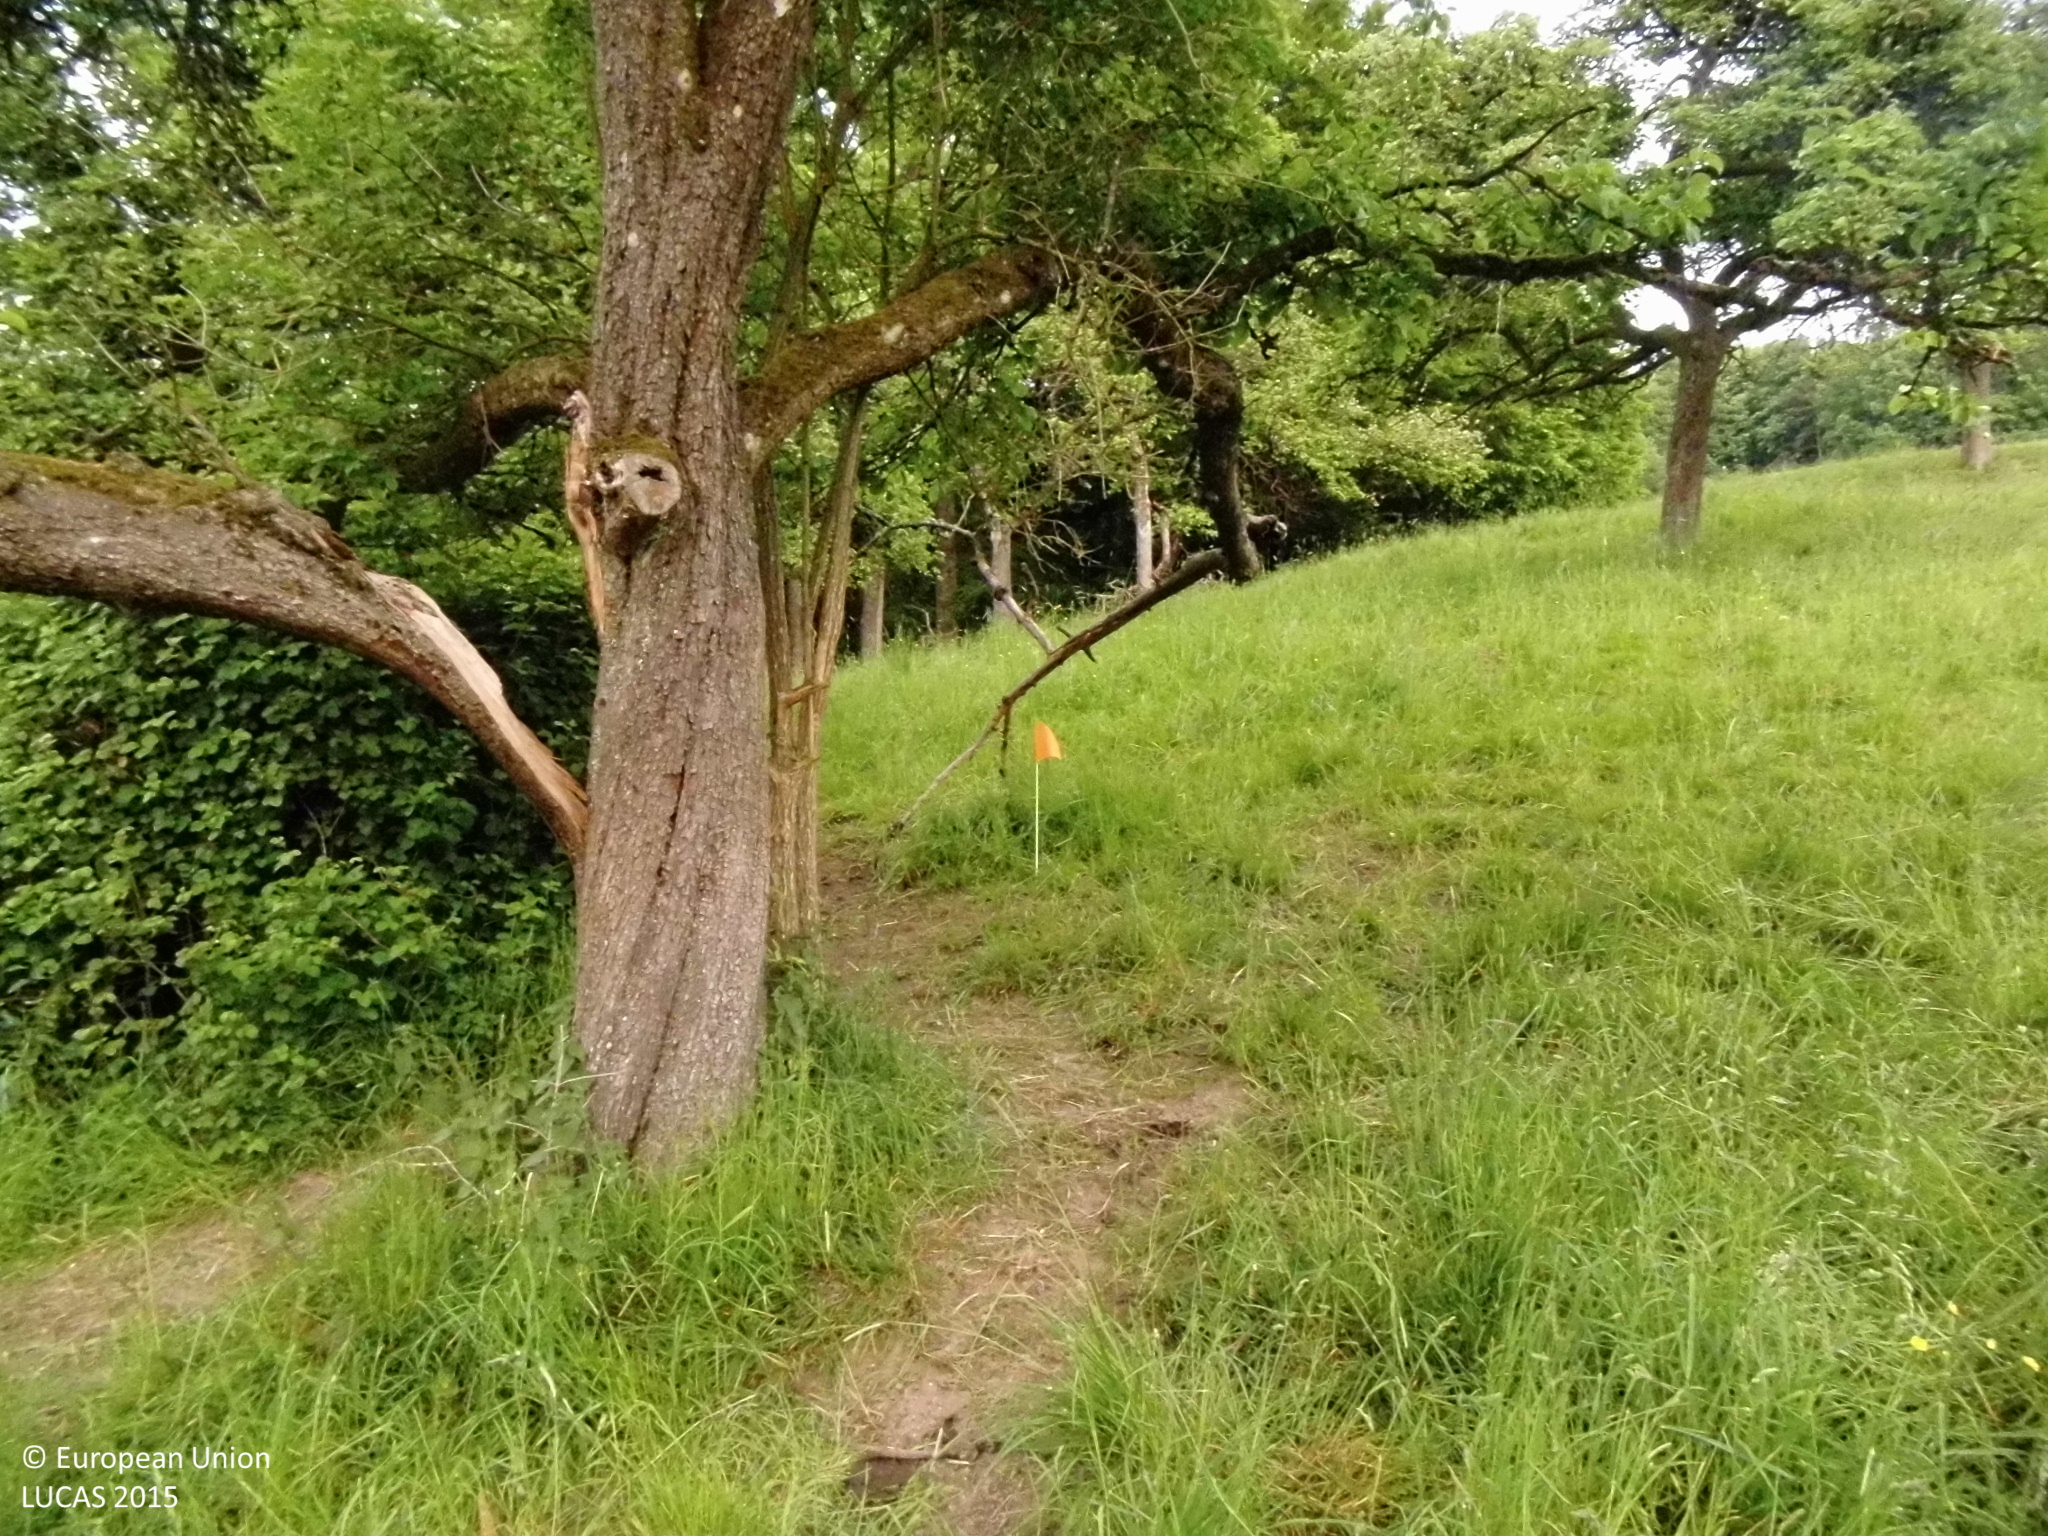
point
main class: Cropland
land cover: Apple fruit
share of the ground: 10 - 25 %
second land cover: Grassland without tree/shrub cover
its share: > 75 %
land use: Agriculture (excluding fallow land and kitchen gardens)
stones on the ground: 10 - 25 %
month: May
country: DE
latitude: 50.7317
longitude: 7.4642
